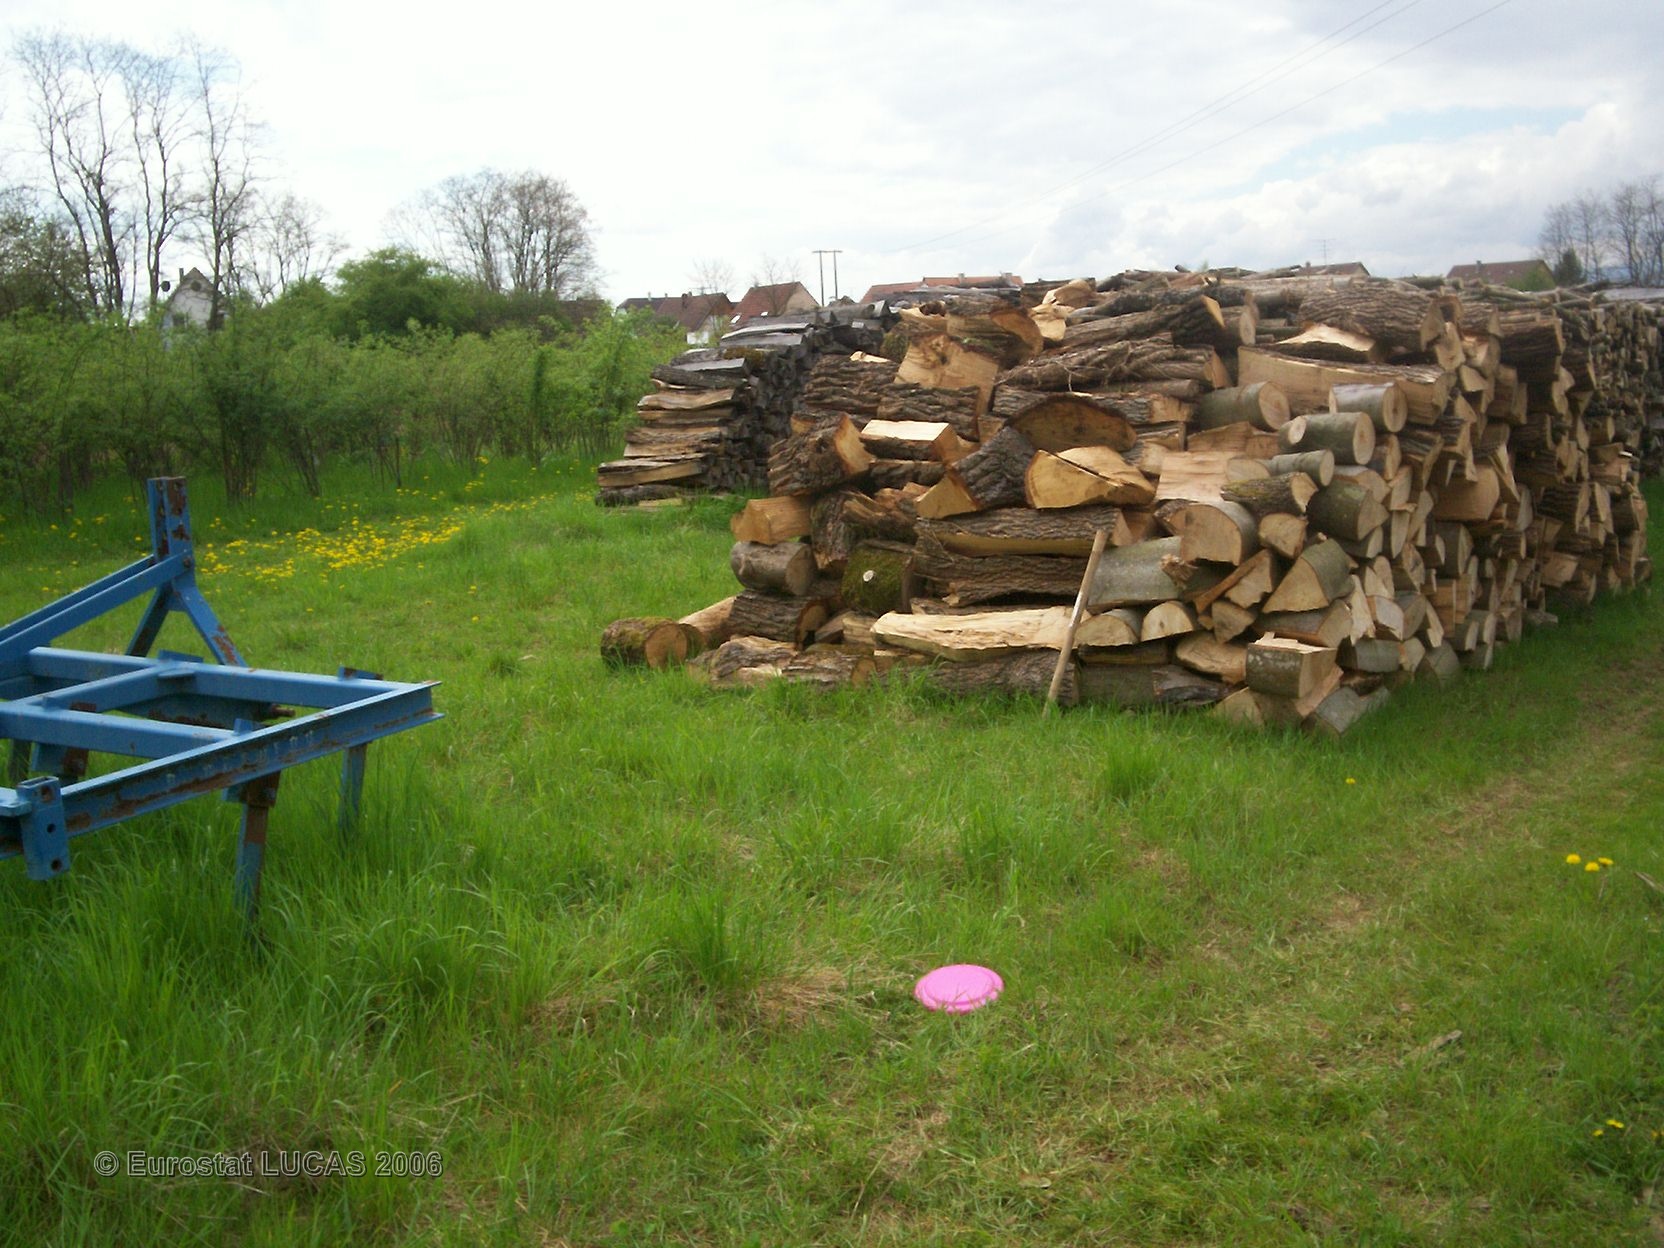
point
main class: Grassland
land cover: Grassland without tree/shrub cover
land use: Logistics and storage
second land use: Agriculture (excluding fallow land and kitchen gardens)
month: April
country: FR
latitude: 48.0492
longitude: 7.4120
